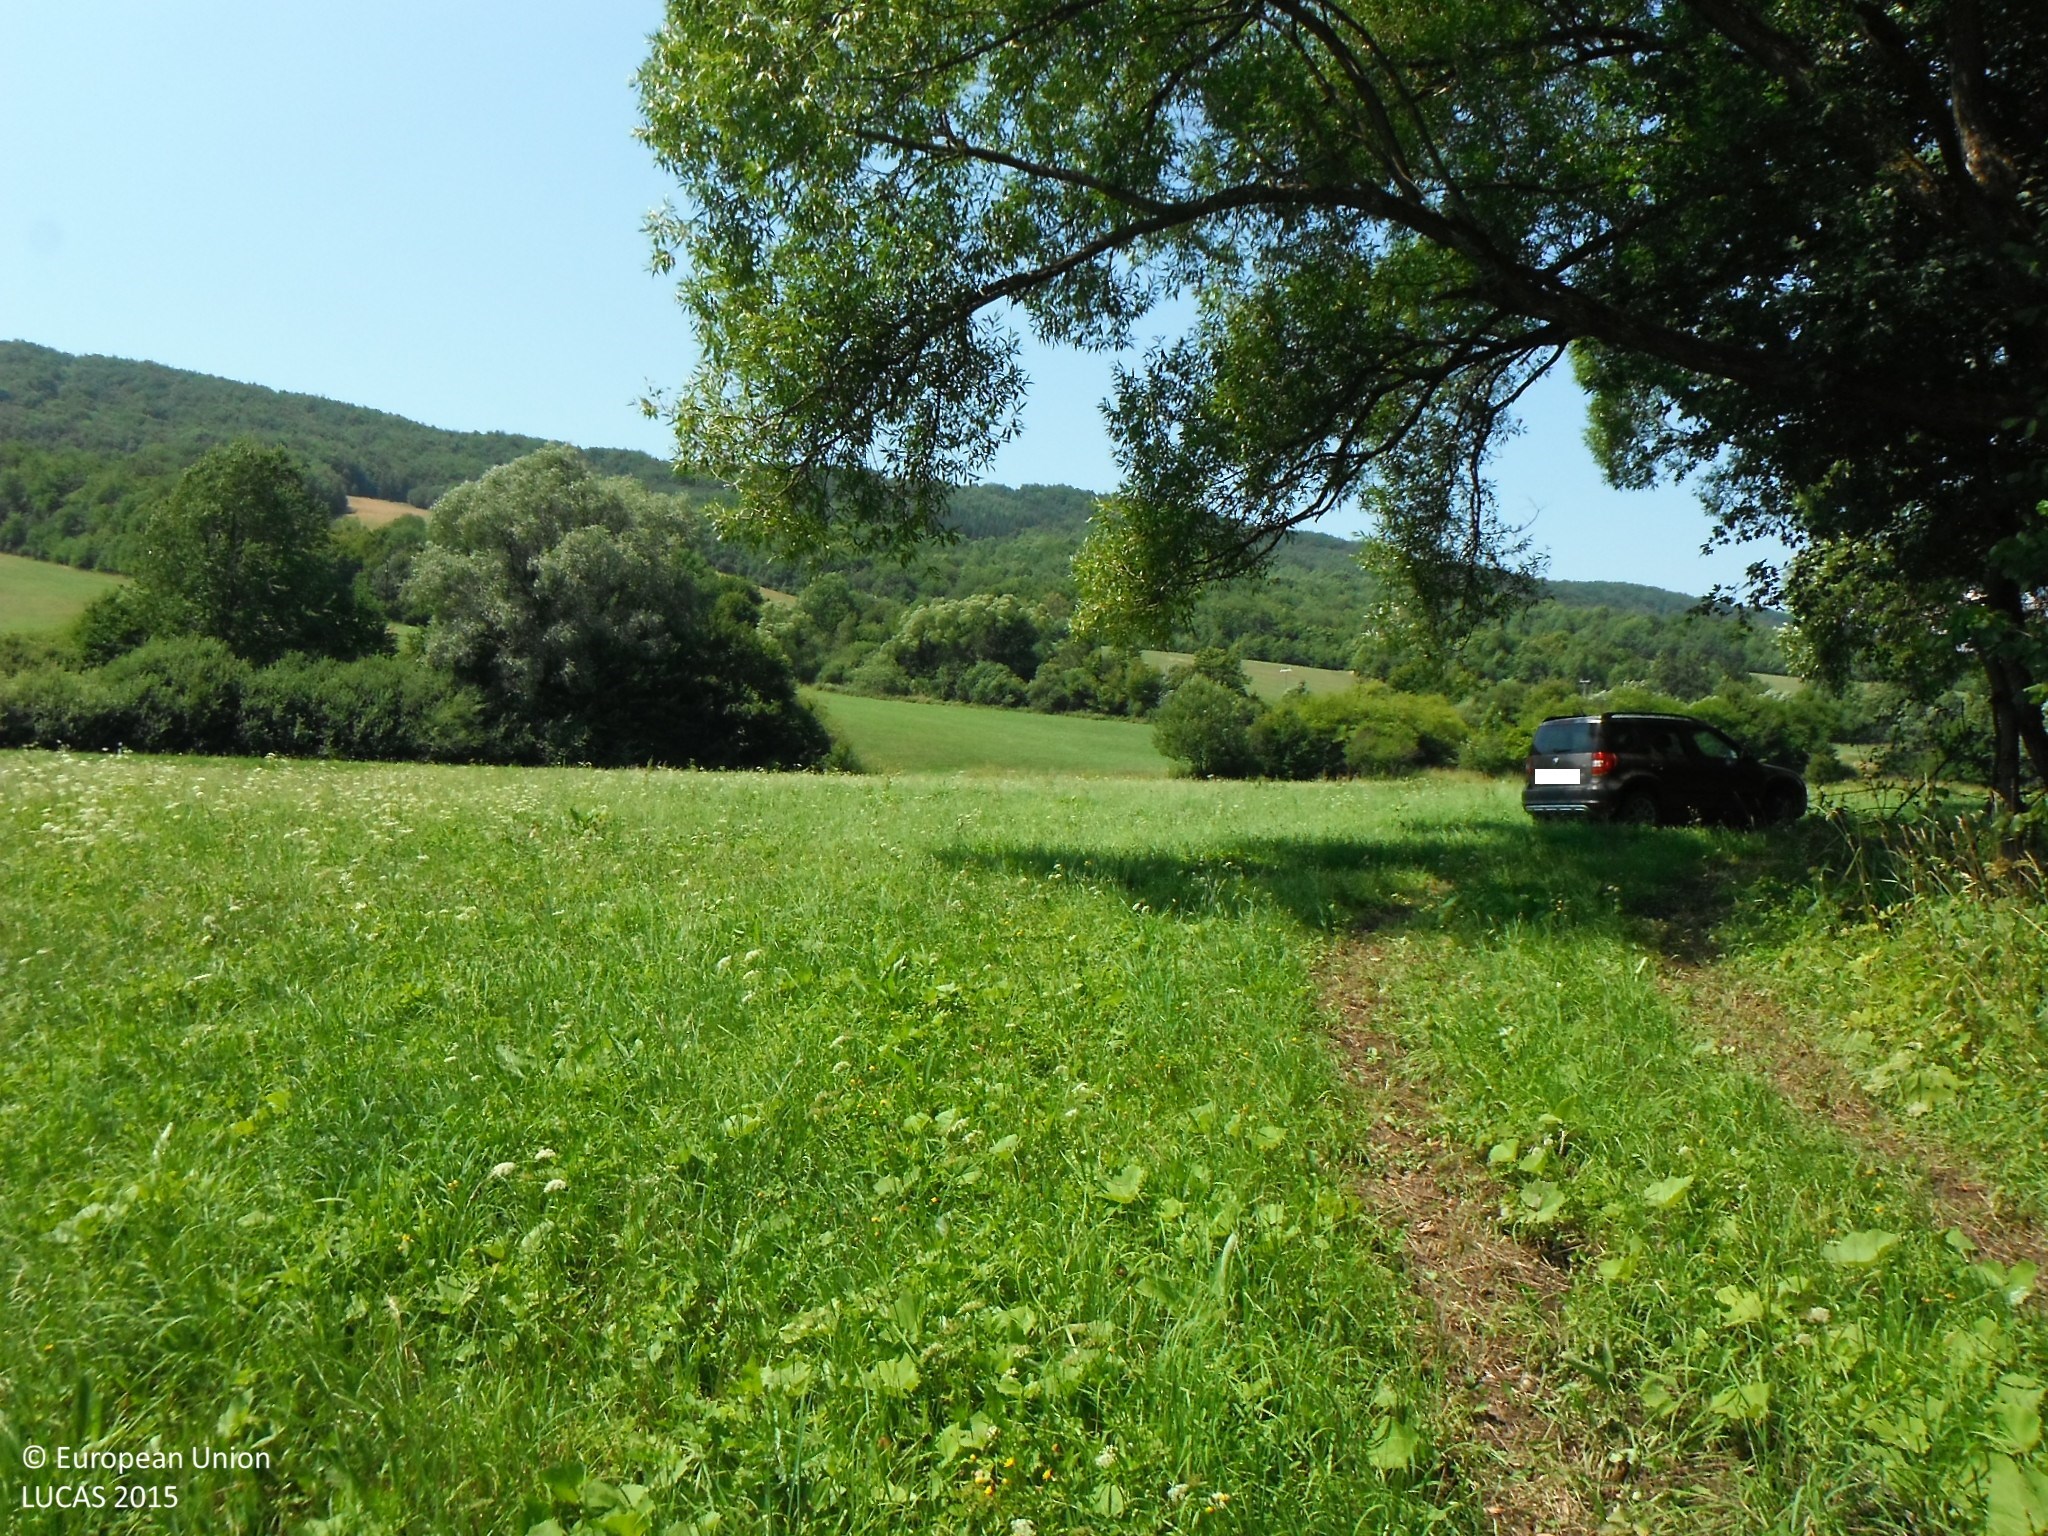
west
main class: Grassland
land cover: Grassland without tree/shrub cover
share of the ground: > 75 %
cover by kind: herbaceous plants 100 %
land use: Agriculture (excluding fallow land and kitchen gardens)
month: July
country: SK
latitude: 49.3010
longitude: 21.7557
